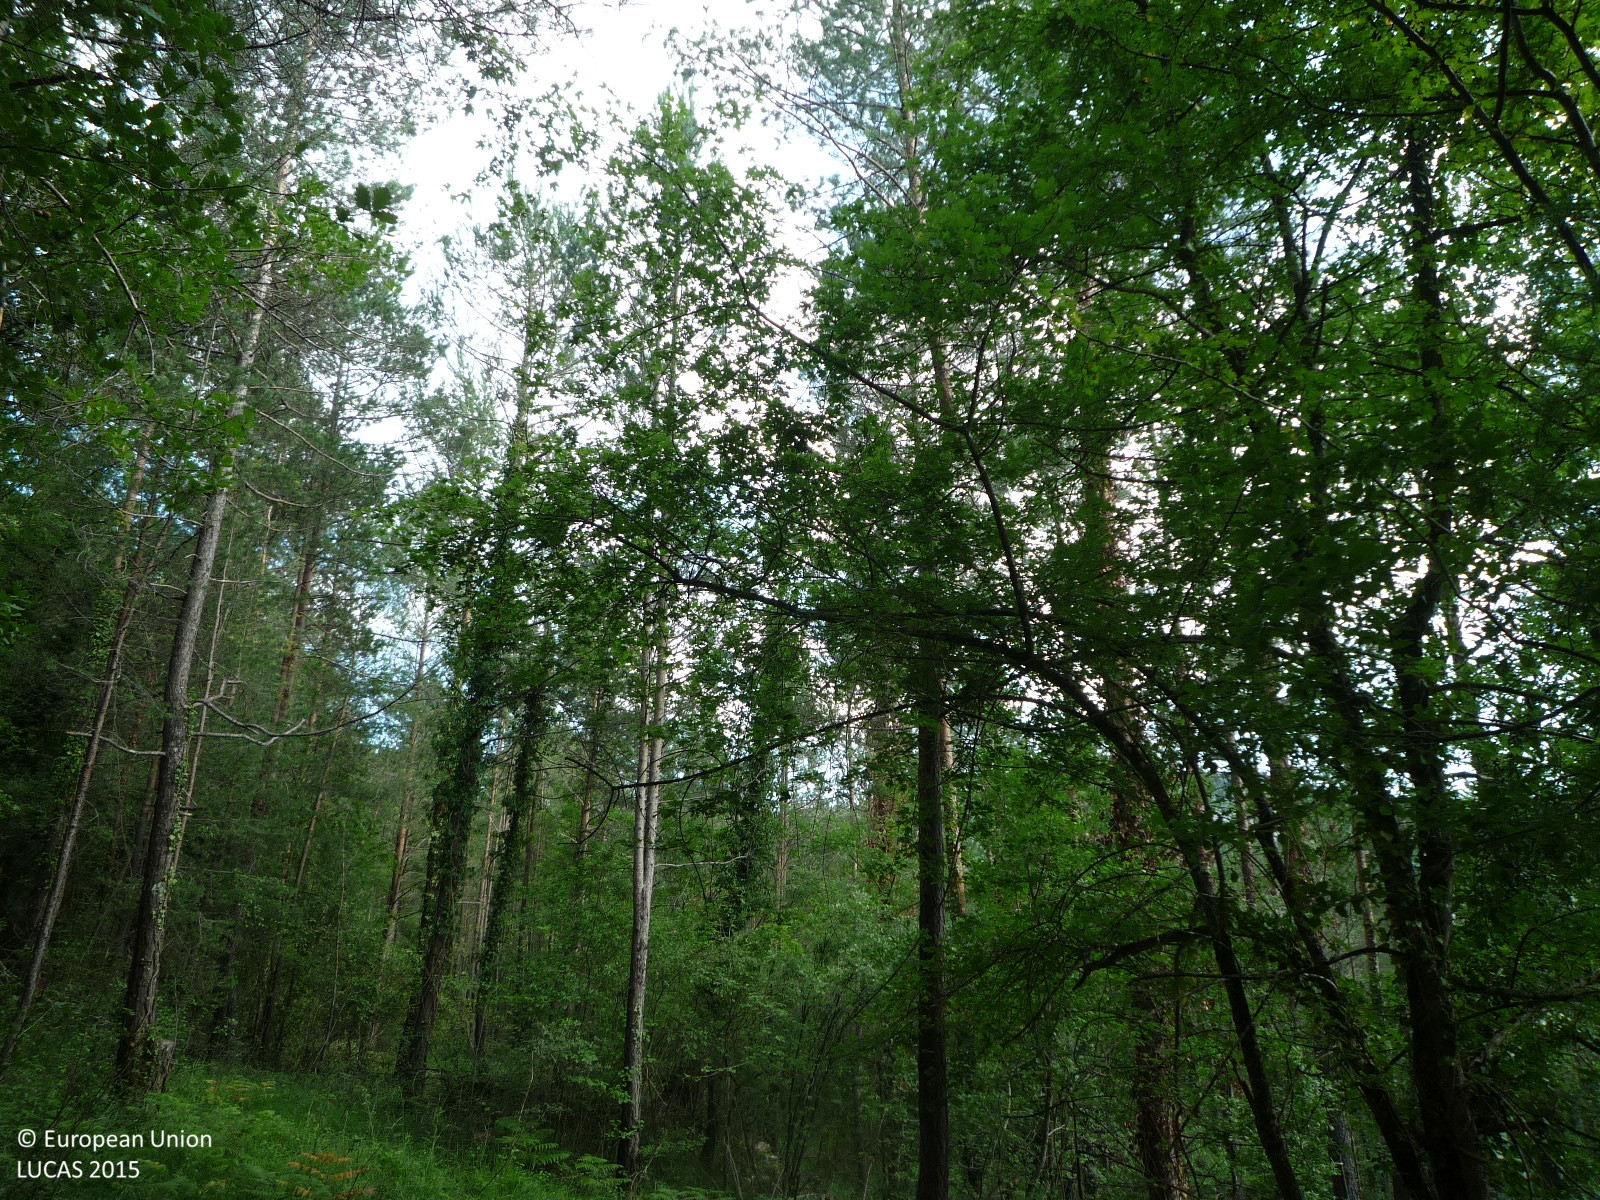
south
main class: Woodland
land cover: Pine dominated mixed woodland
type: coniferous forest of the mediterranean region
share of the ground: > 75 %
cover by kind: coniferous forest trees 60 %, broadleaved forest trees 30 %, herbaceous plants 10 %
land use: Forestry
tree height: > 5 m
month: June
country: ES
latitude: 42.1350
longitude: 1.9676
